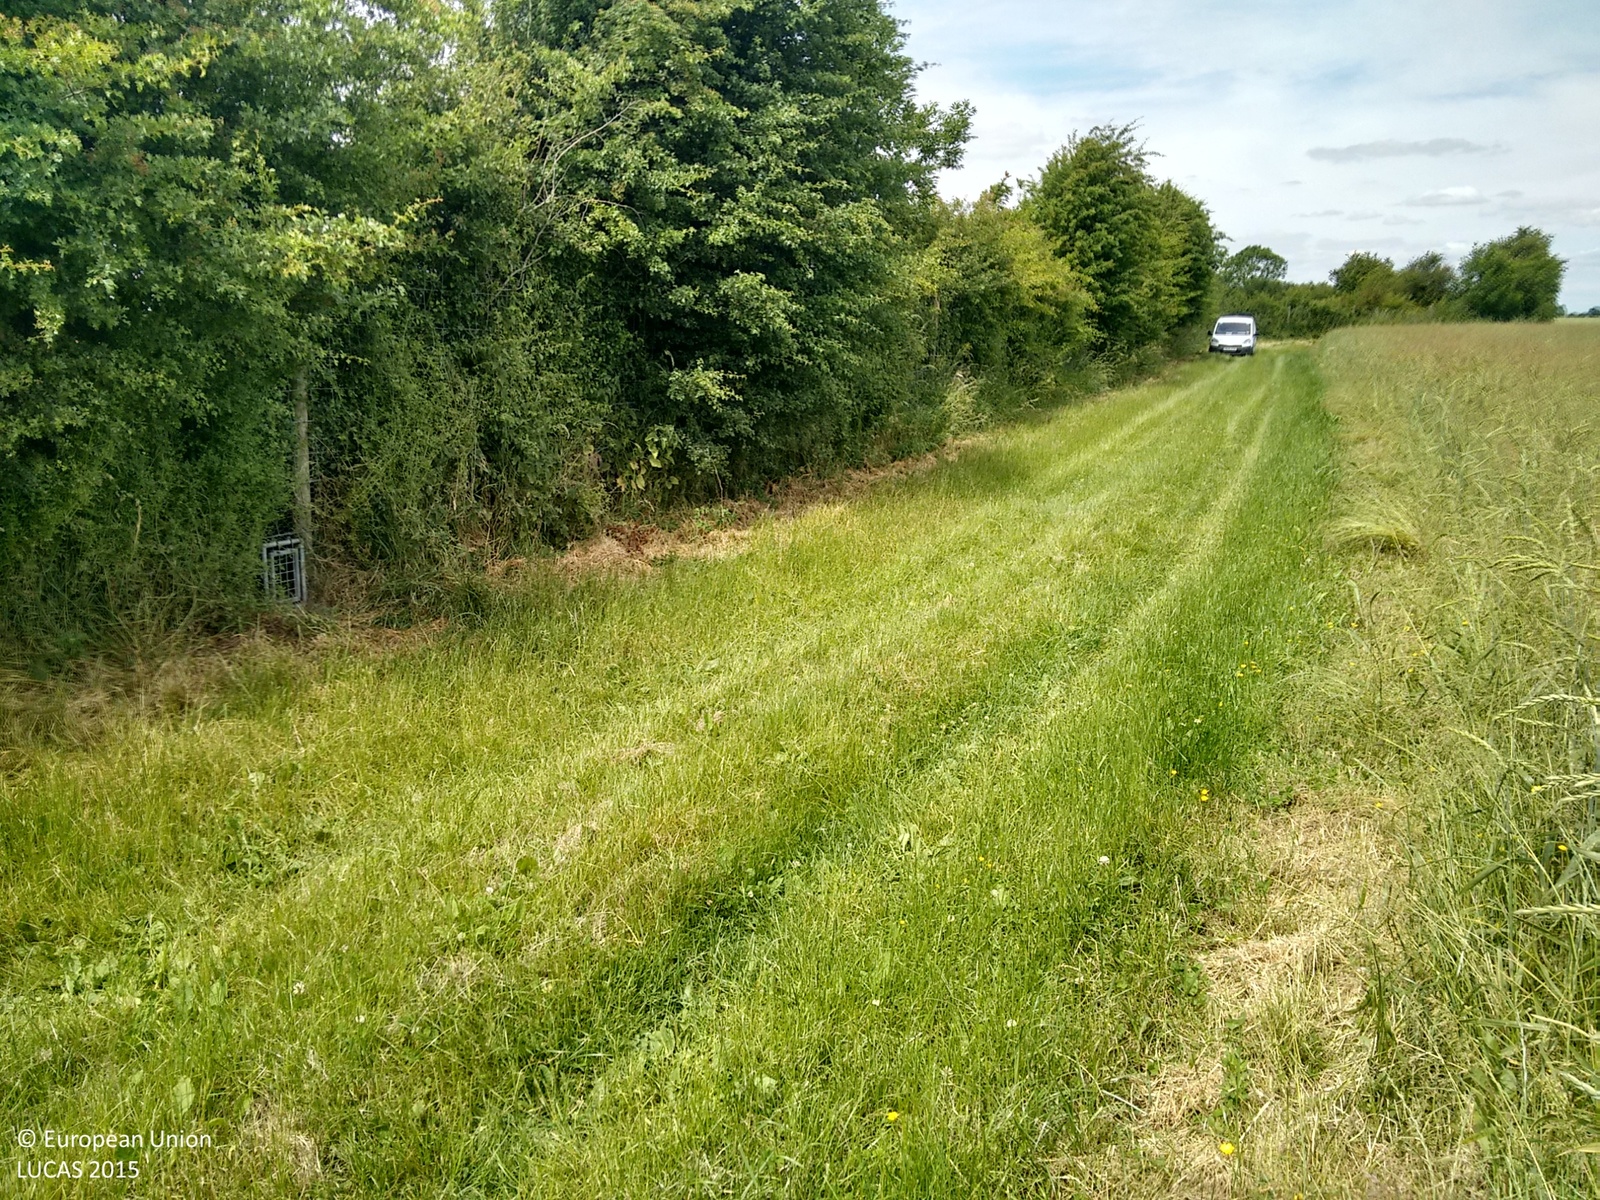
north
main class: Cropland
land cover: Mixed cereals for fodder
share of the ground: > 75 %
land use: Agriculture (excluding fallow land and kitchen gardens)
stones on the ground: < 10 %
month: June
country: GB
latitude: 51.4492
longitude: -1.8995
